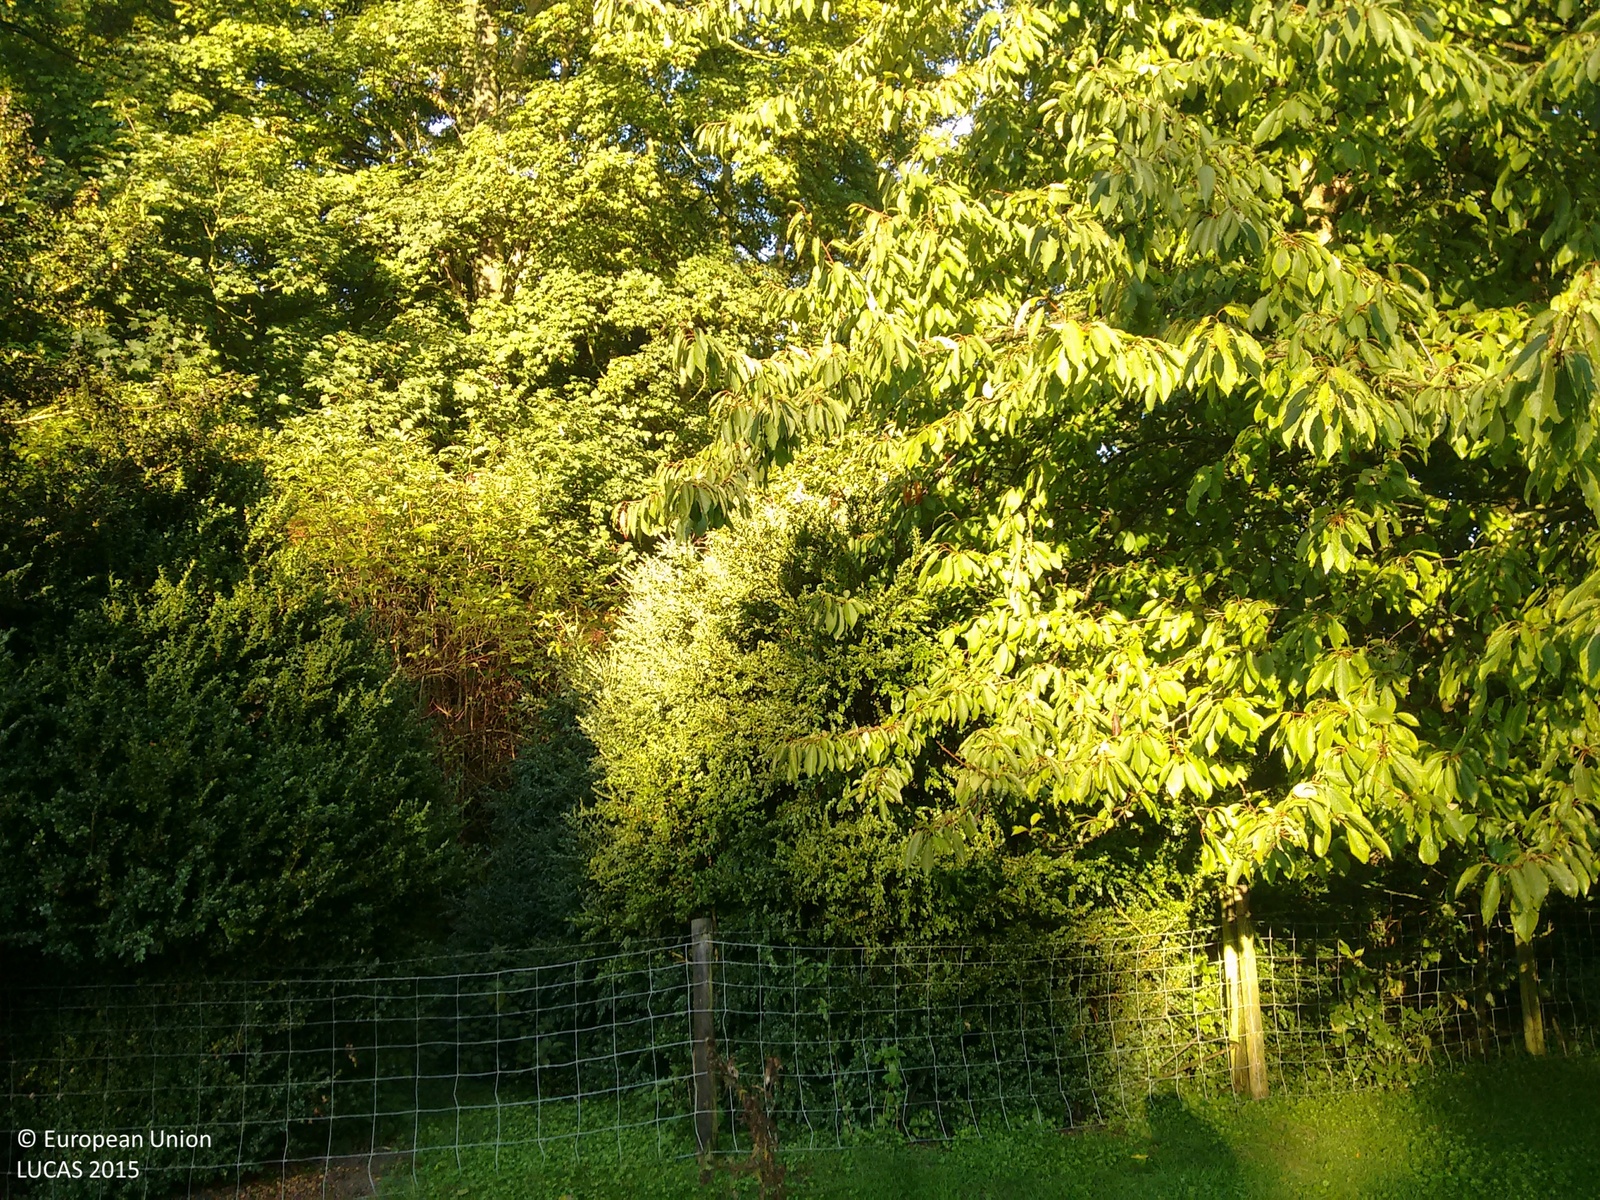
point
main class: Woodland
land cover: Broadleaved woodland
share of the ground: > 75 %
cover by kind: broadleaved forest trees 90 %, shrubs 10 %
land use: Sport
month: September
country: GB
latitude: 52.2299
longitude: 0.2630
